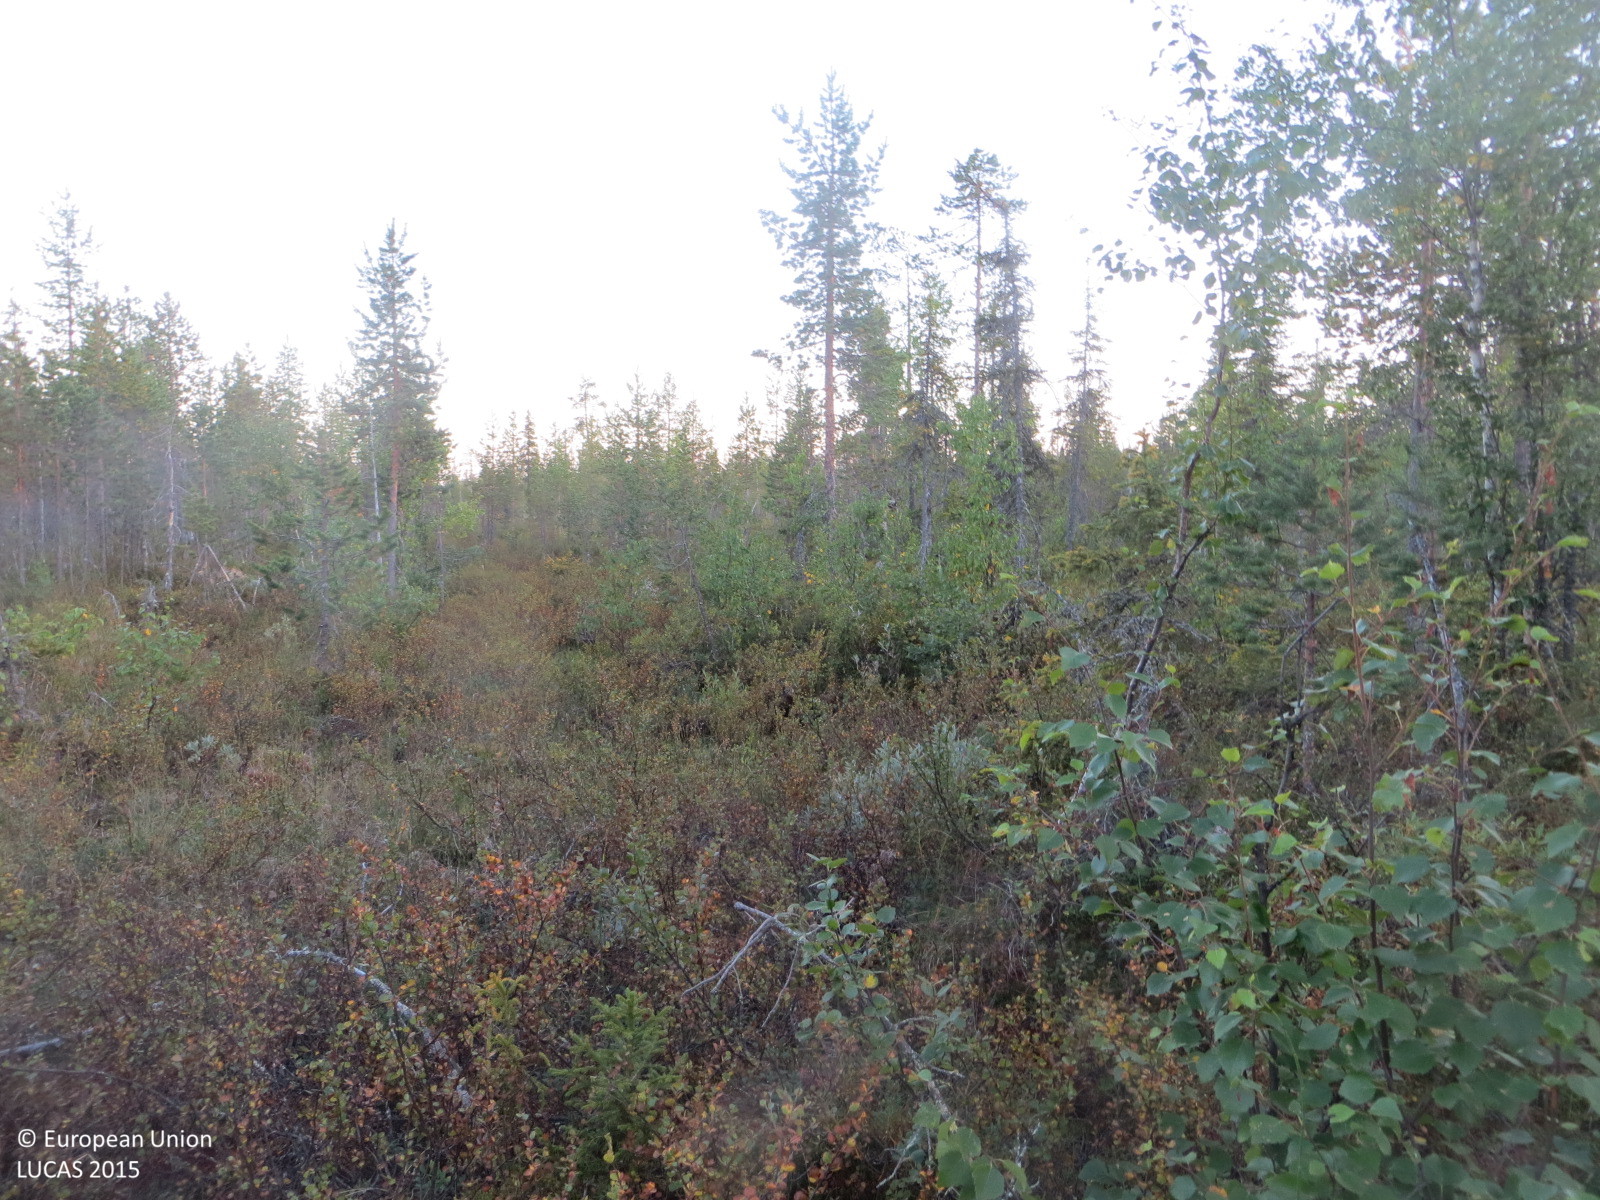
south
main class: Woodland
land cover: Pine dominated mixed woodland
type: mire and swamp forests
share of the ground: 50 - 75 %
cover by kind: shrubs 50 %, coniferous forest trees 30 %, broadleaved forest trees 20 %
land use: Forestry
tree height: > 5 m
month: August
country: FI
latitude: 67.7420
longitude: 24.8667
